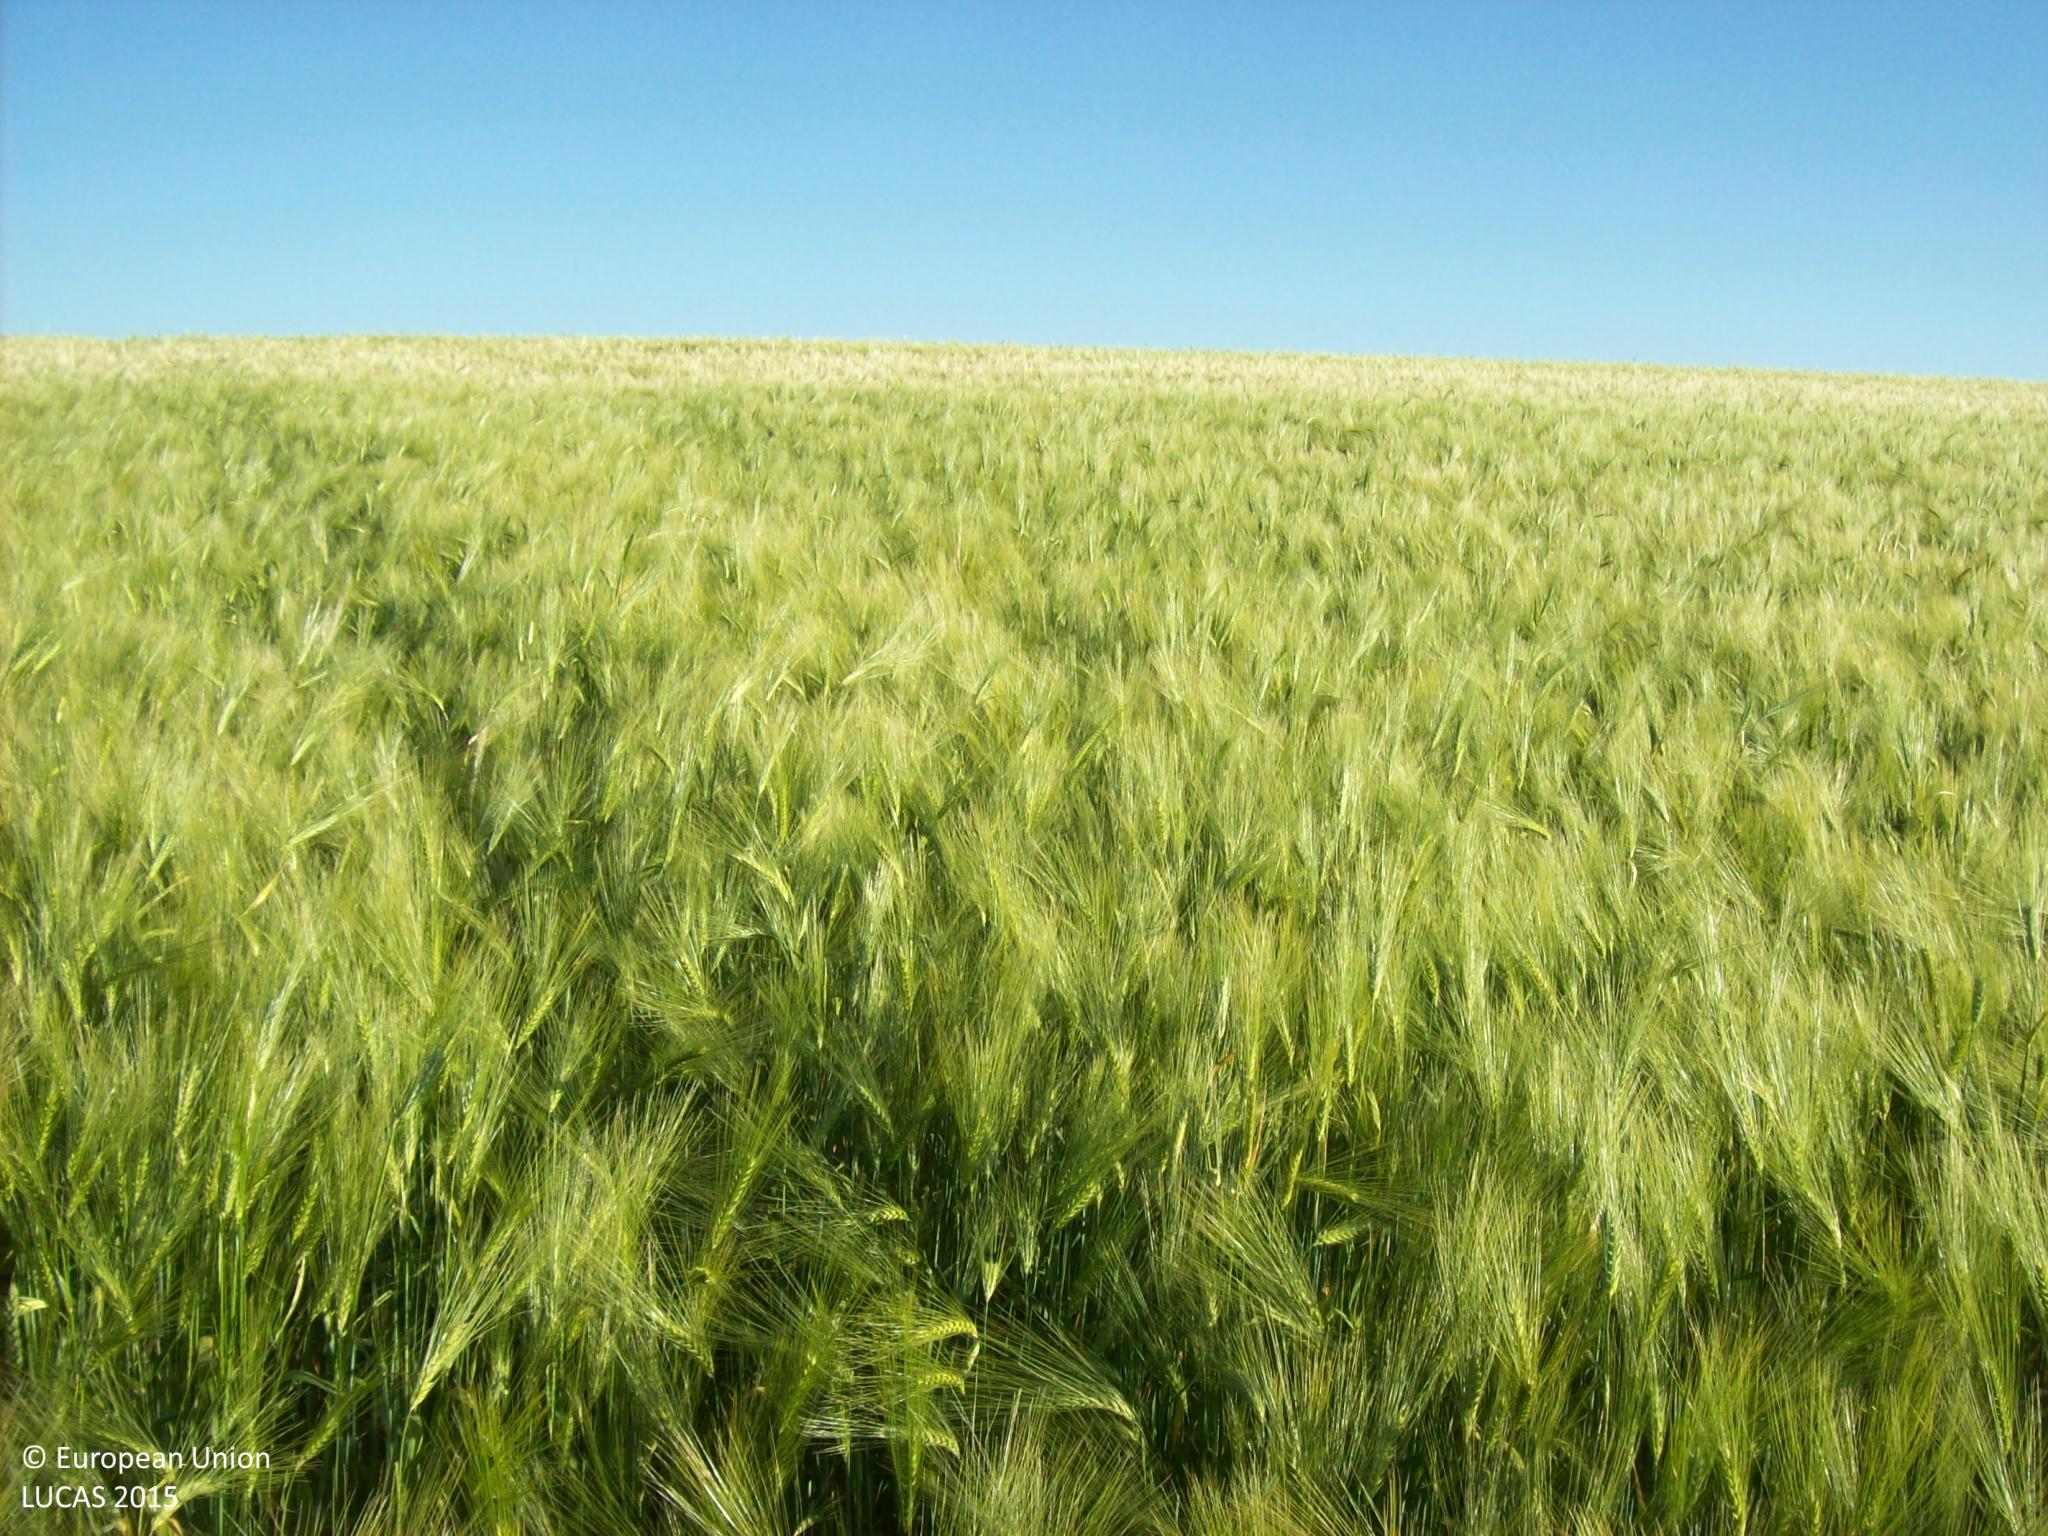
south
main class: Cropland
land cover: Barley
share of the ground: > 75 %
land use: Agriculture (excluding fallow land and kitchen gardens)
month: May
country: ES
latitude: 40.7664
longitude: -4.9527
